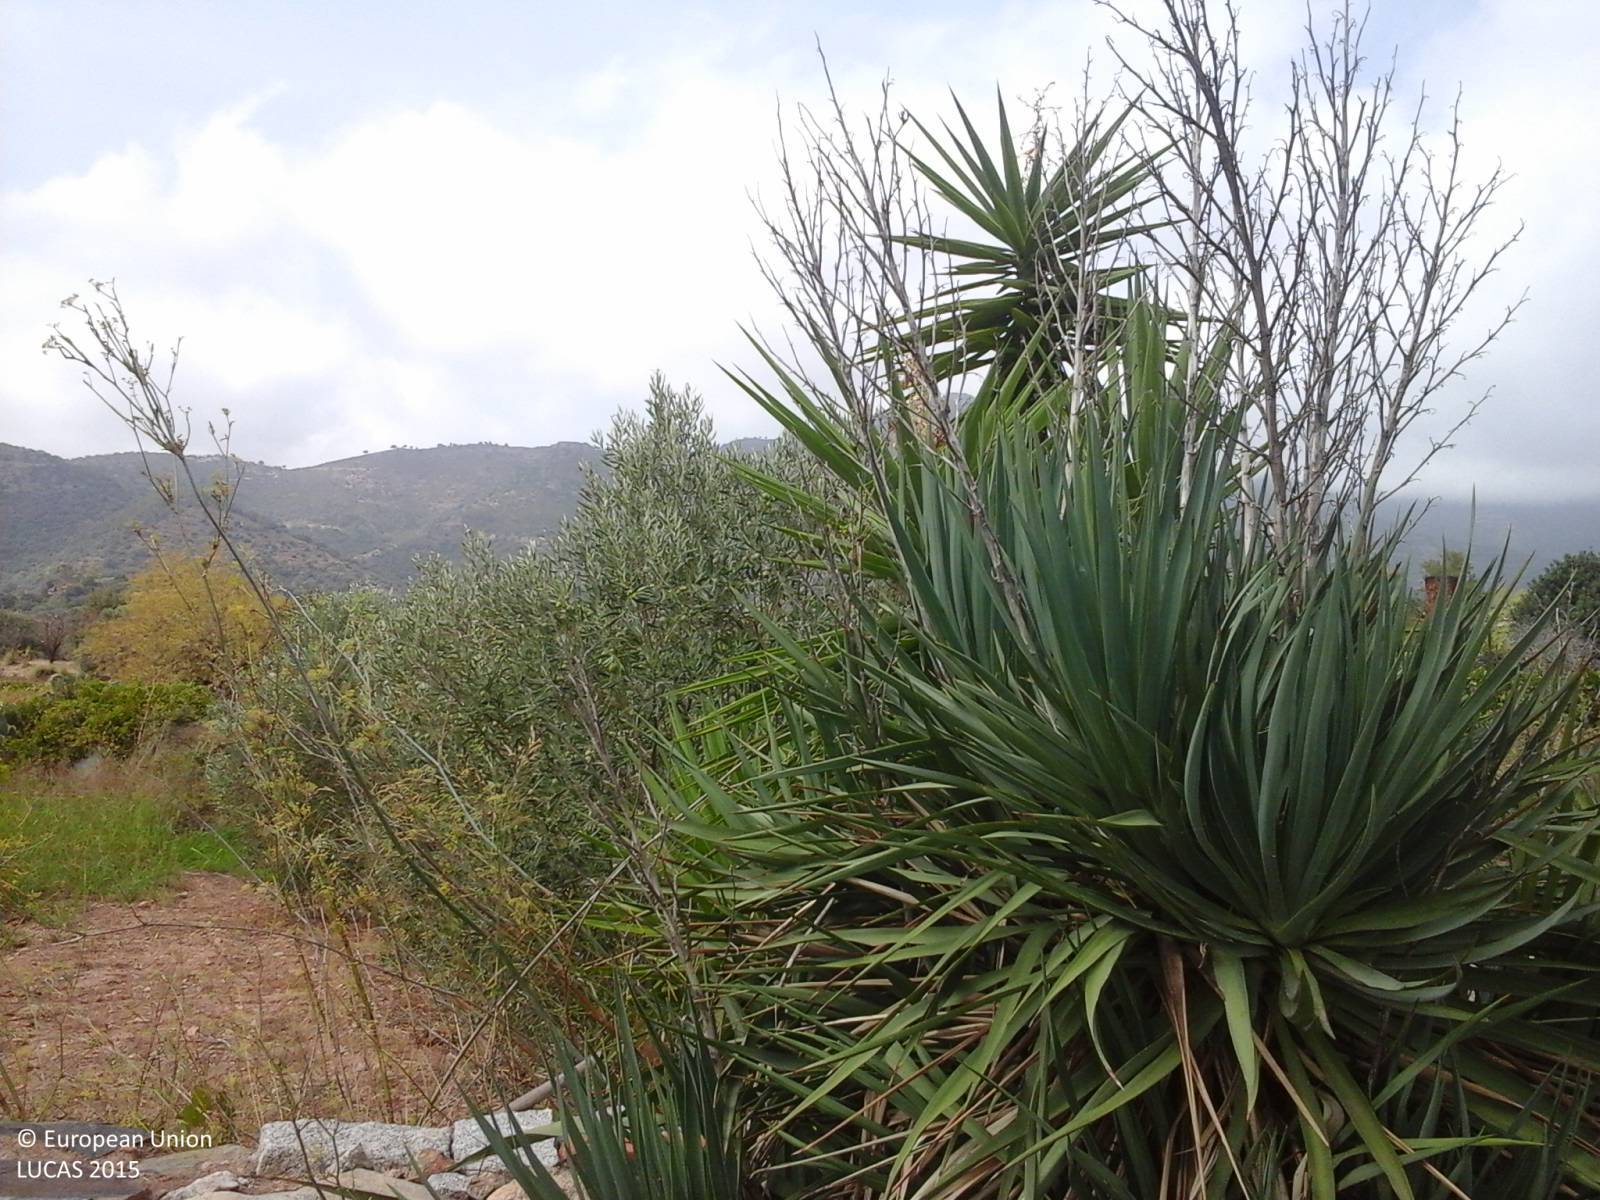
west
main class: Cropland
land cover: Vineyards
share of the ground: > 75 %
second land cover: Other bare soil
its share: > 75 %
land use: Agriculture (excluding fallow land and kitchen gardens)
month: September
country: IT
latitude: 39.8137
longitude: 9.5702
